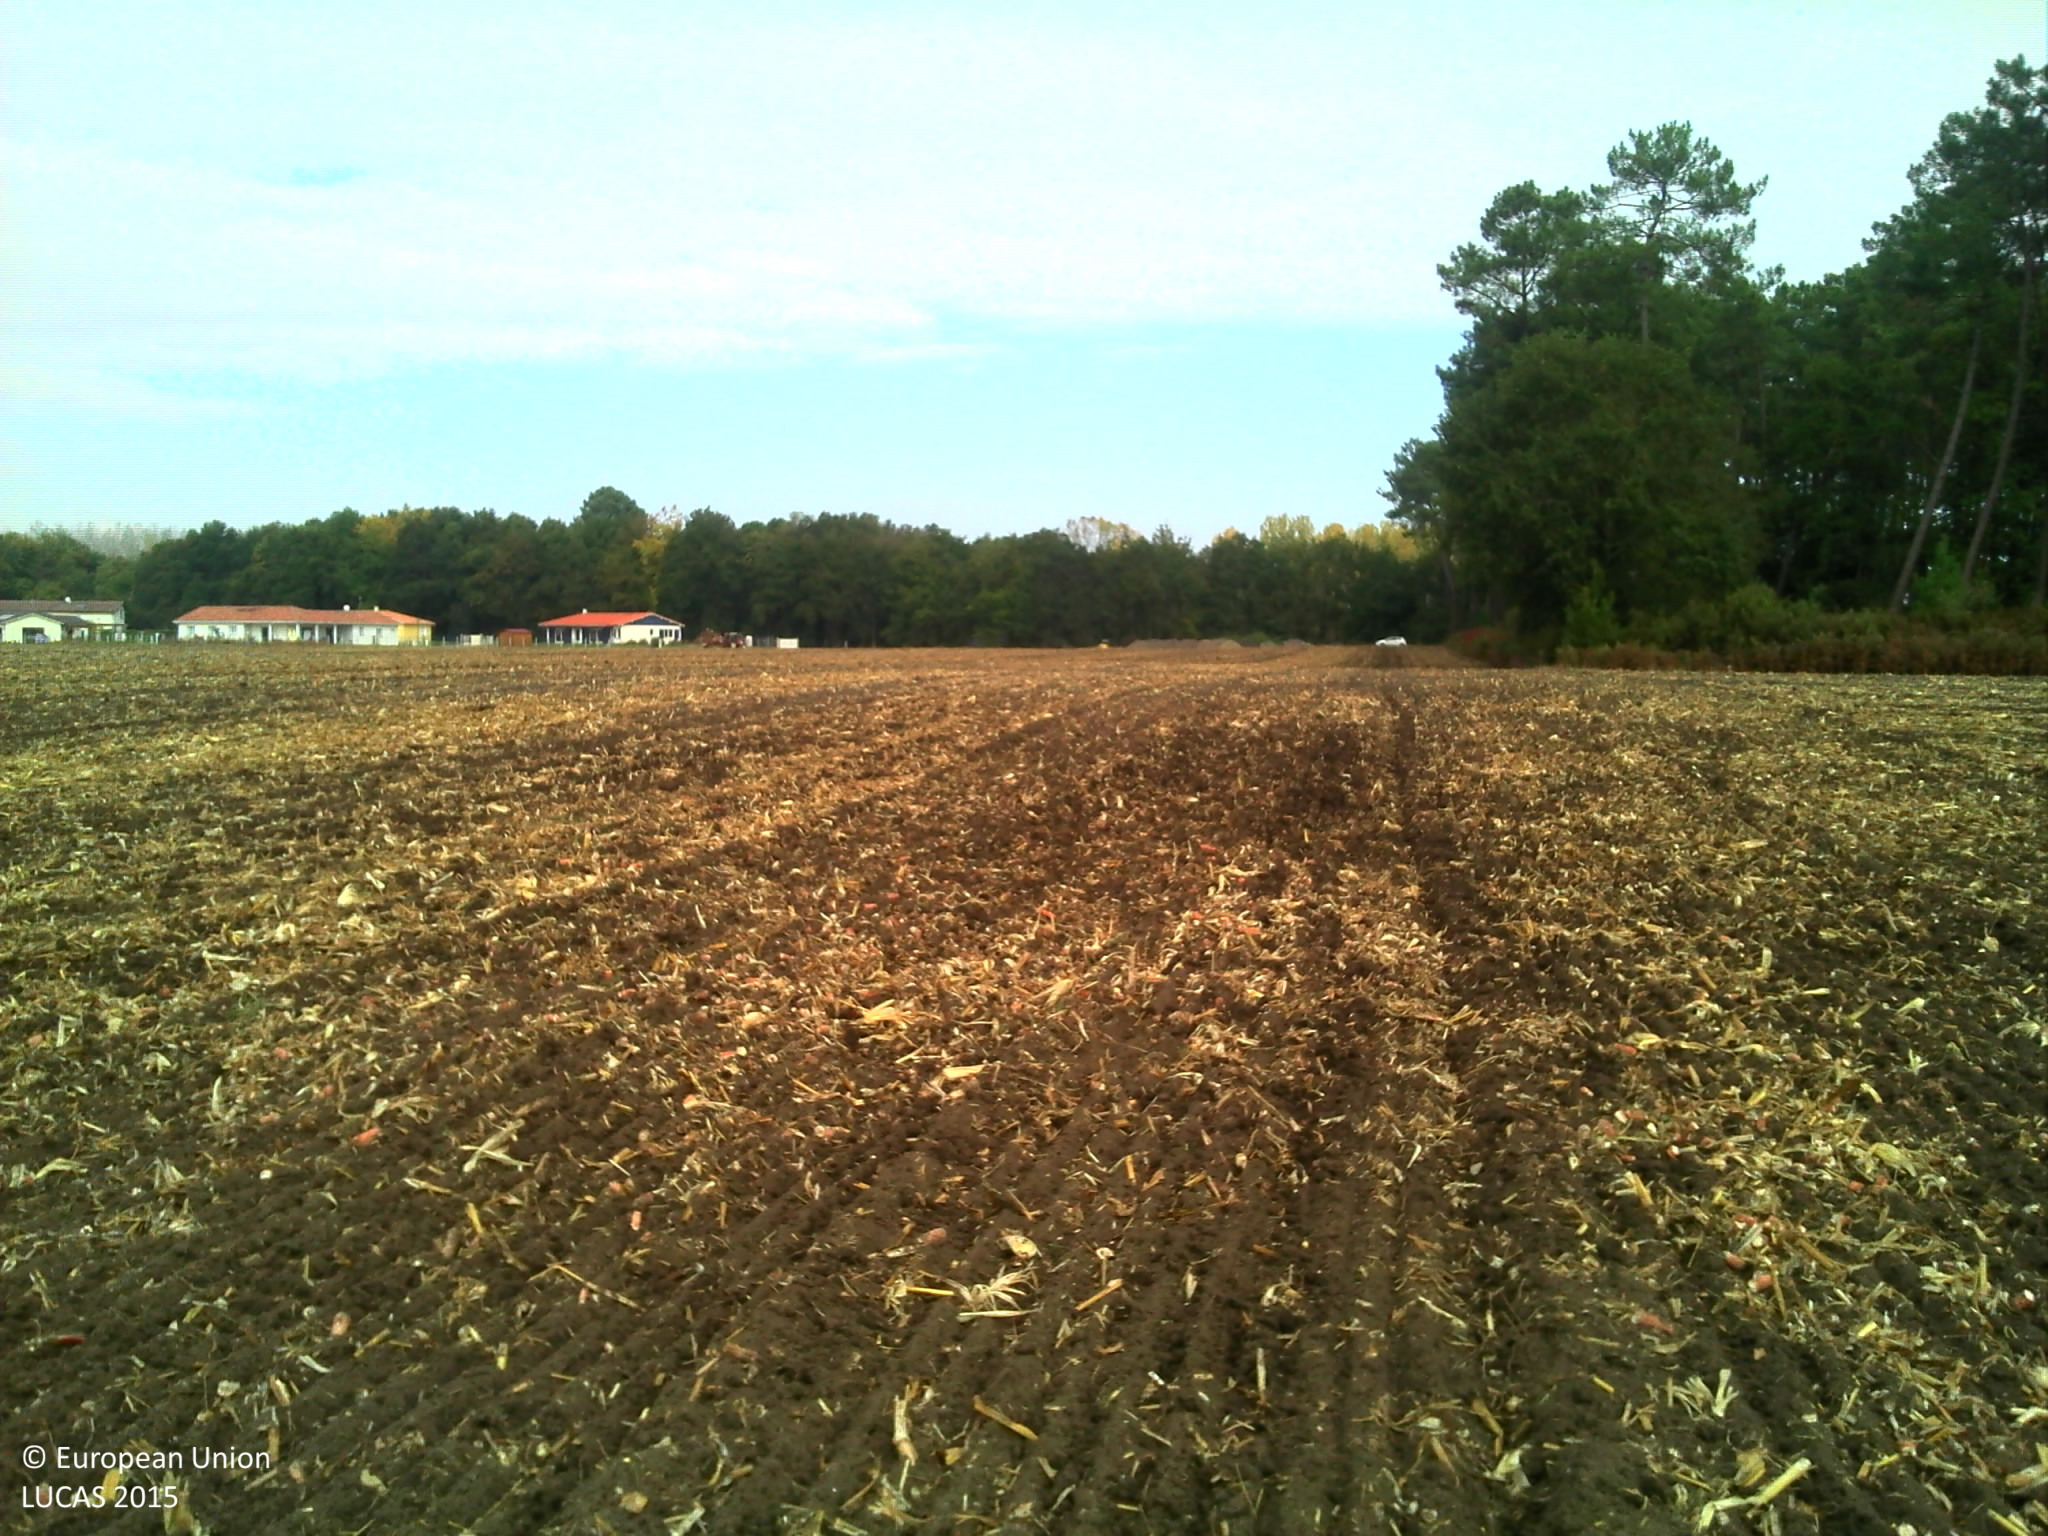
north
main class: Cropland
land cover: Maize
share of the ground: > 75 %
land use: Agriculture (excluding fallow land and kitchen gardens)
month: October
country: FR
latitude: 43.8757
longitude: -0.8042
